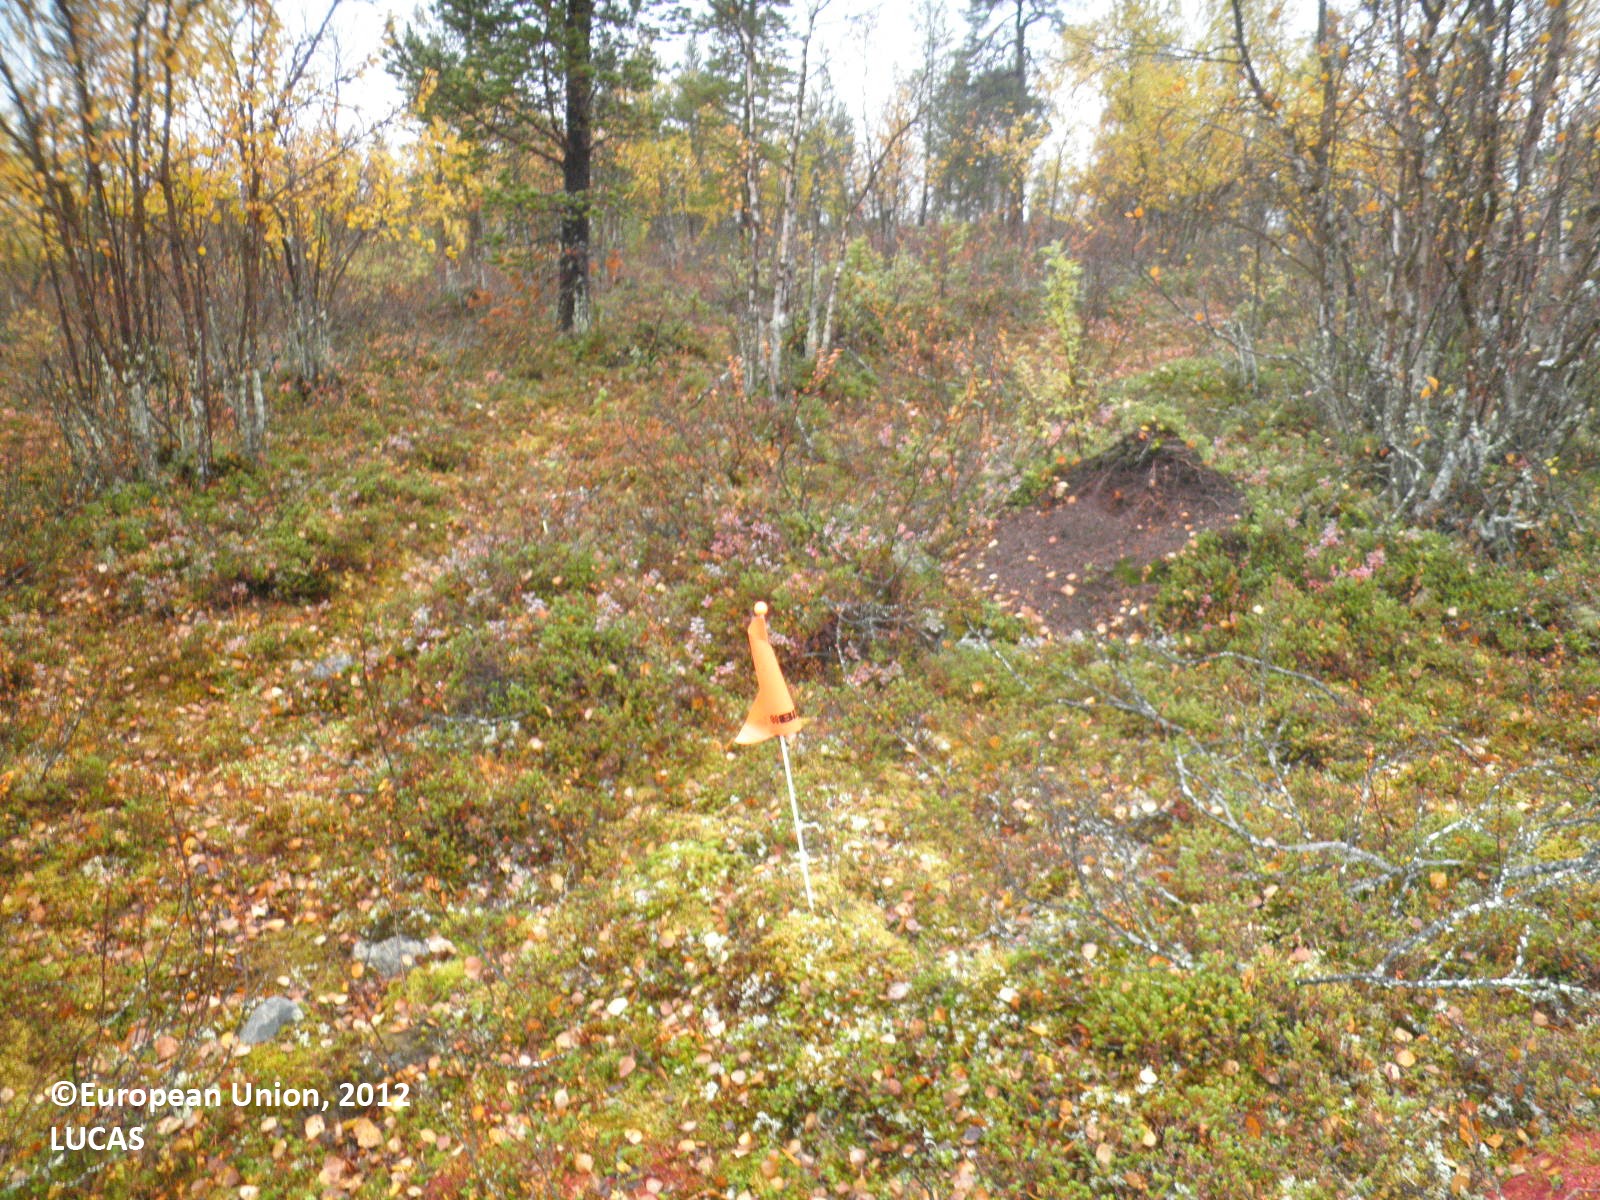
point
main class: Woodland
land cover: Broadleaved woodland
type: boreal forest
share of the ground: 50 - 75 %
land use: Forestry
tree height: > 5 m
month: September
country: FI
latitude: 68.4454
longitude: 22.7017
